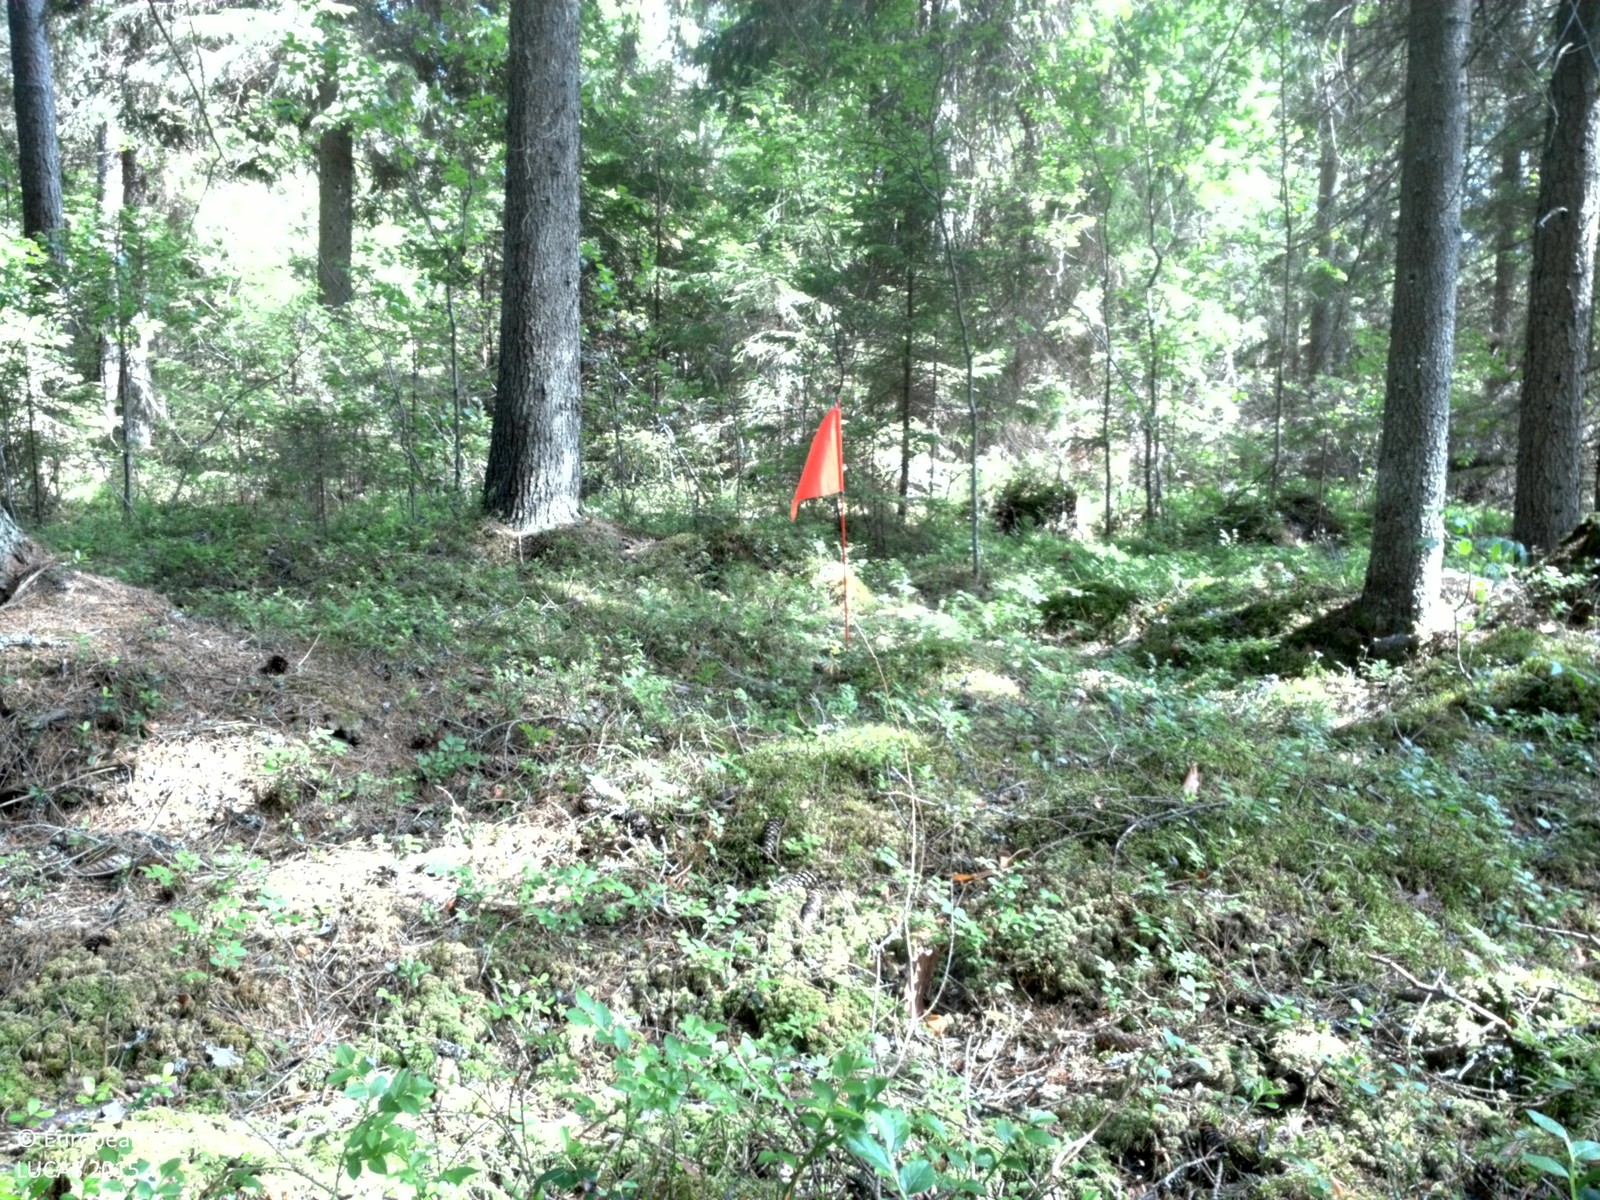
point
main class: Woodland
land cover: Spruce dominated coniferous woodland
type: boreal forest
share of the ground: > 75 %
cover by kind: coniferous forest trees 70 %, herbaceous plants 20 %, broadleaved forest trees 10 %
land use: Forestry
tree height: > 5 m
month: July
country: SE
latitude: 60.0228
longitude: 17.0431
